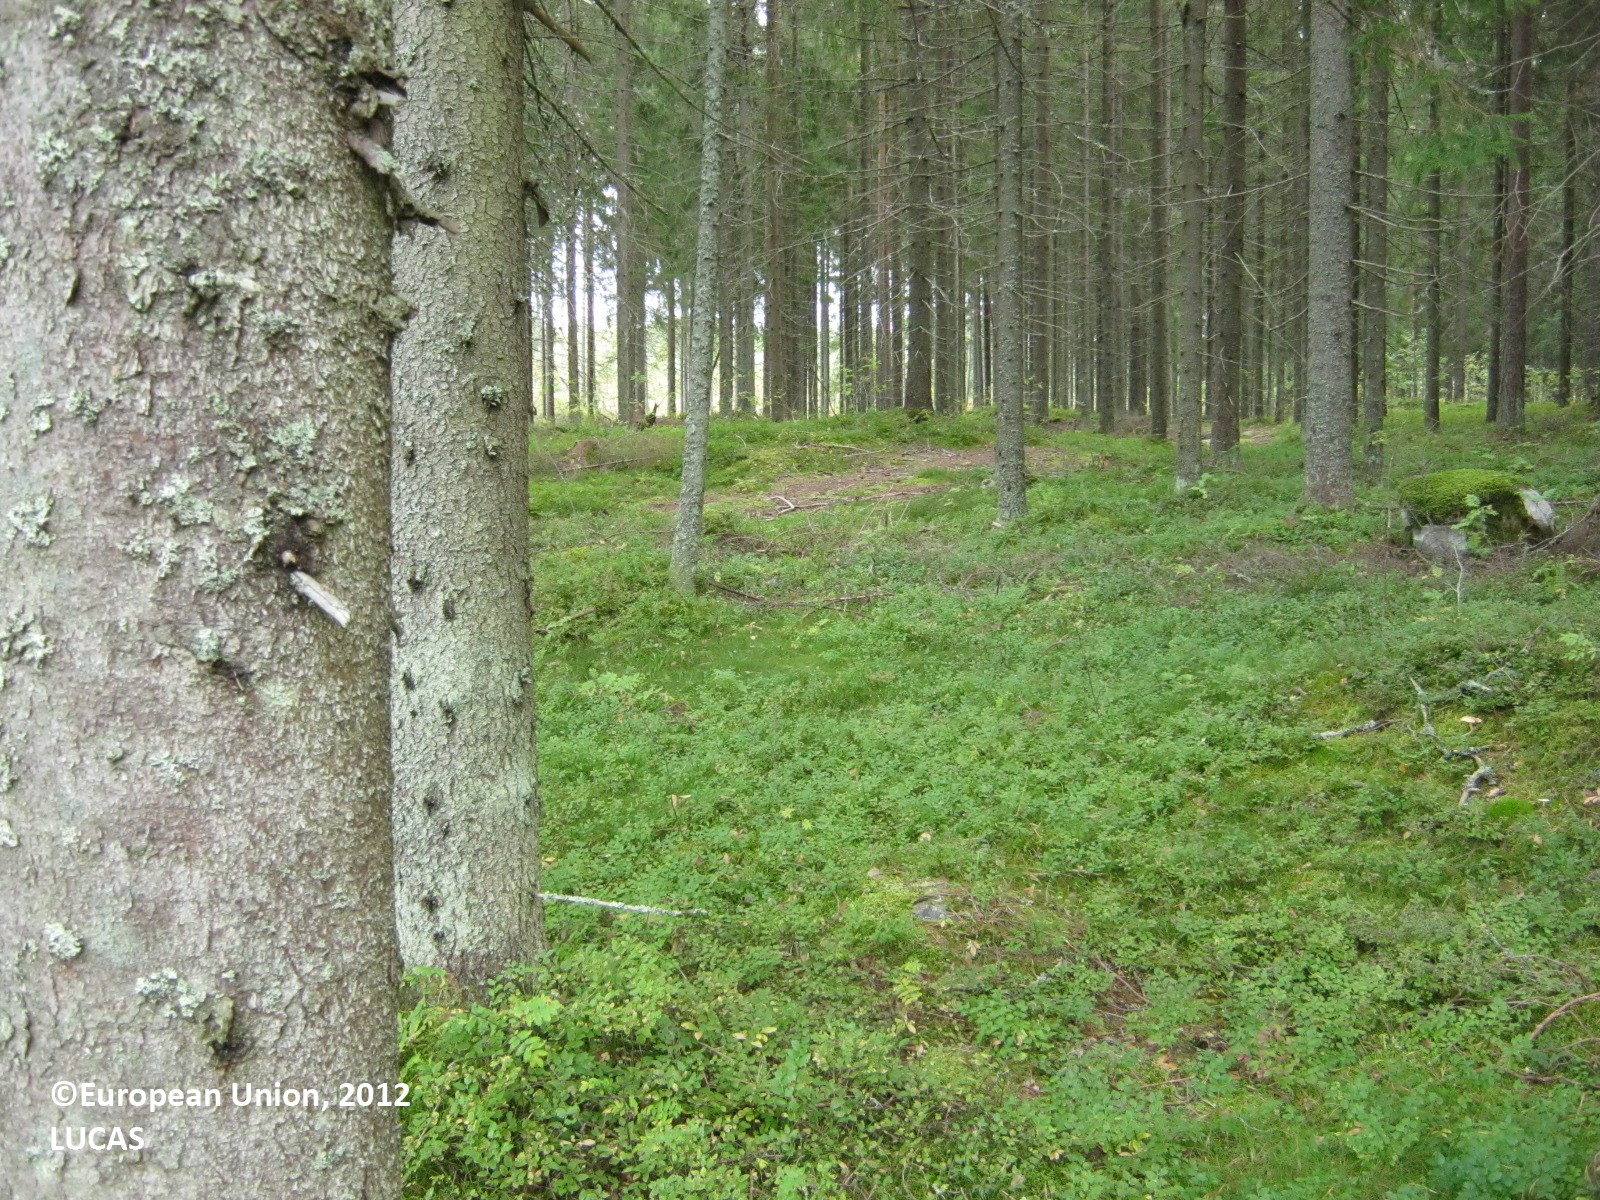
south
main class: Woodland
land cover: Spruce dominated coniferous woodland
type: boreal forest
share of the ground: > 75 %
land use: Forestry
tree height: > 5 m
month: September
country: FI
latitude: 60.7712
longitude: 27.8385
